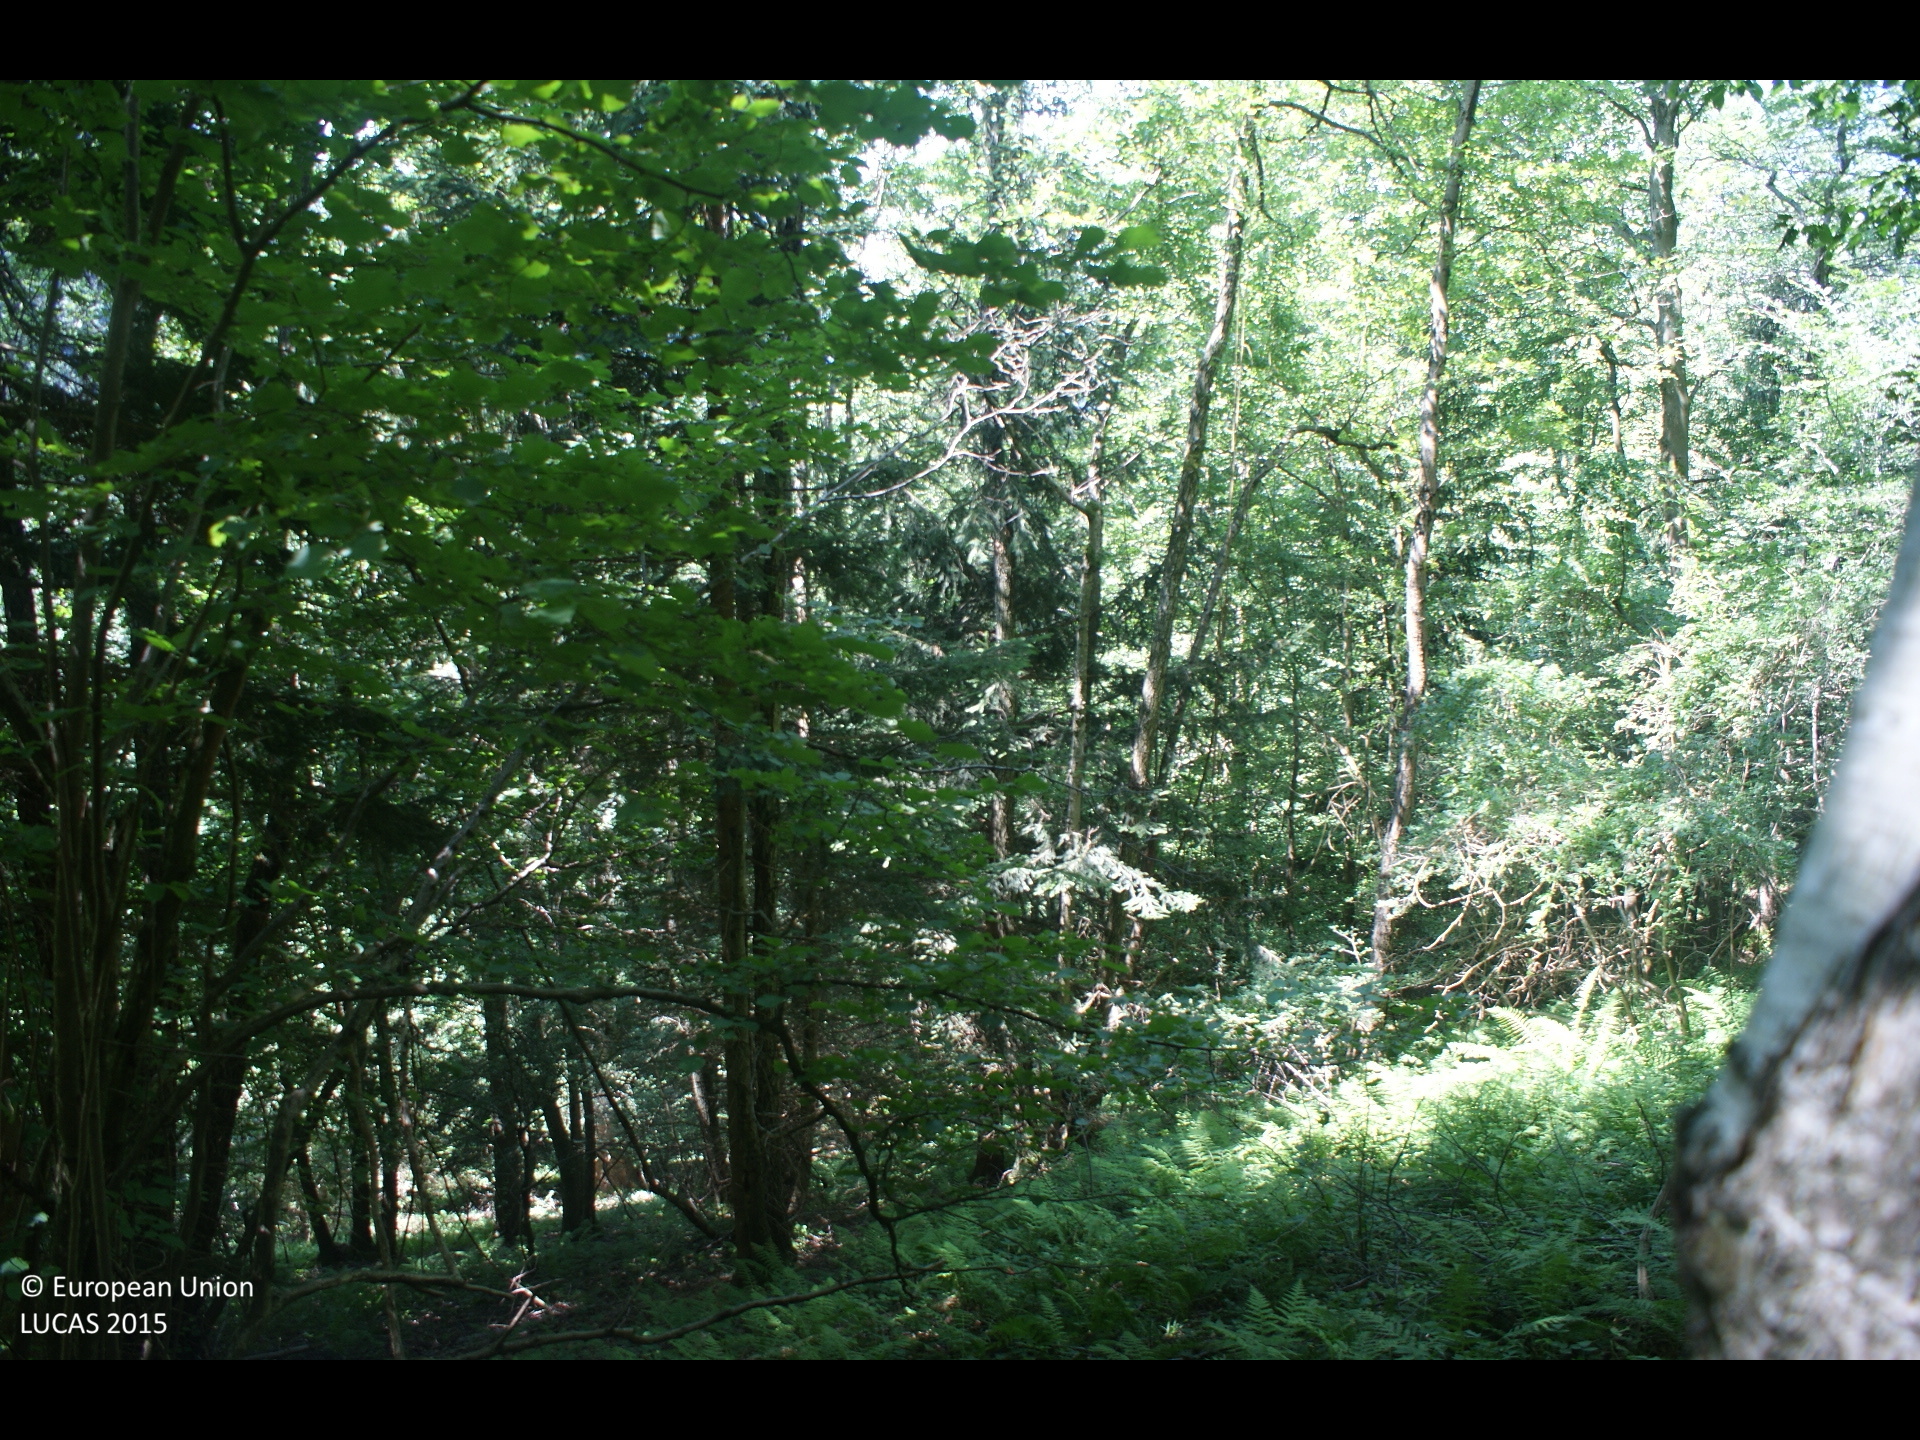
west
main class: Woodland
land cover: Broadleaved woodland
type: mesophytic deciduous forest
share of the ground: > 75 %
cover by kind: broadleaved forest trees 75 %, coniferous forest trees 20 %, herbaceous plants 5 %
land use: Forestry
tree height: > 5 m
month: July
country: AT
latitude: 48.0044
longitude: 14.9467
